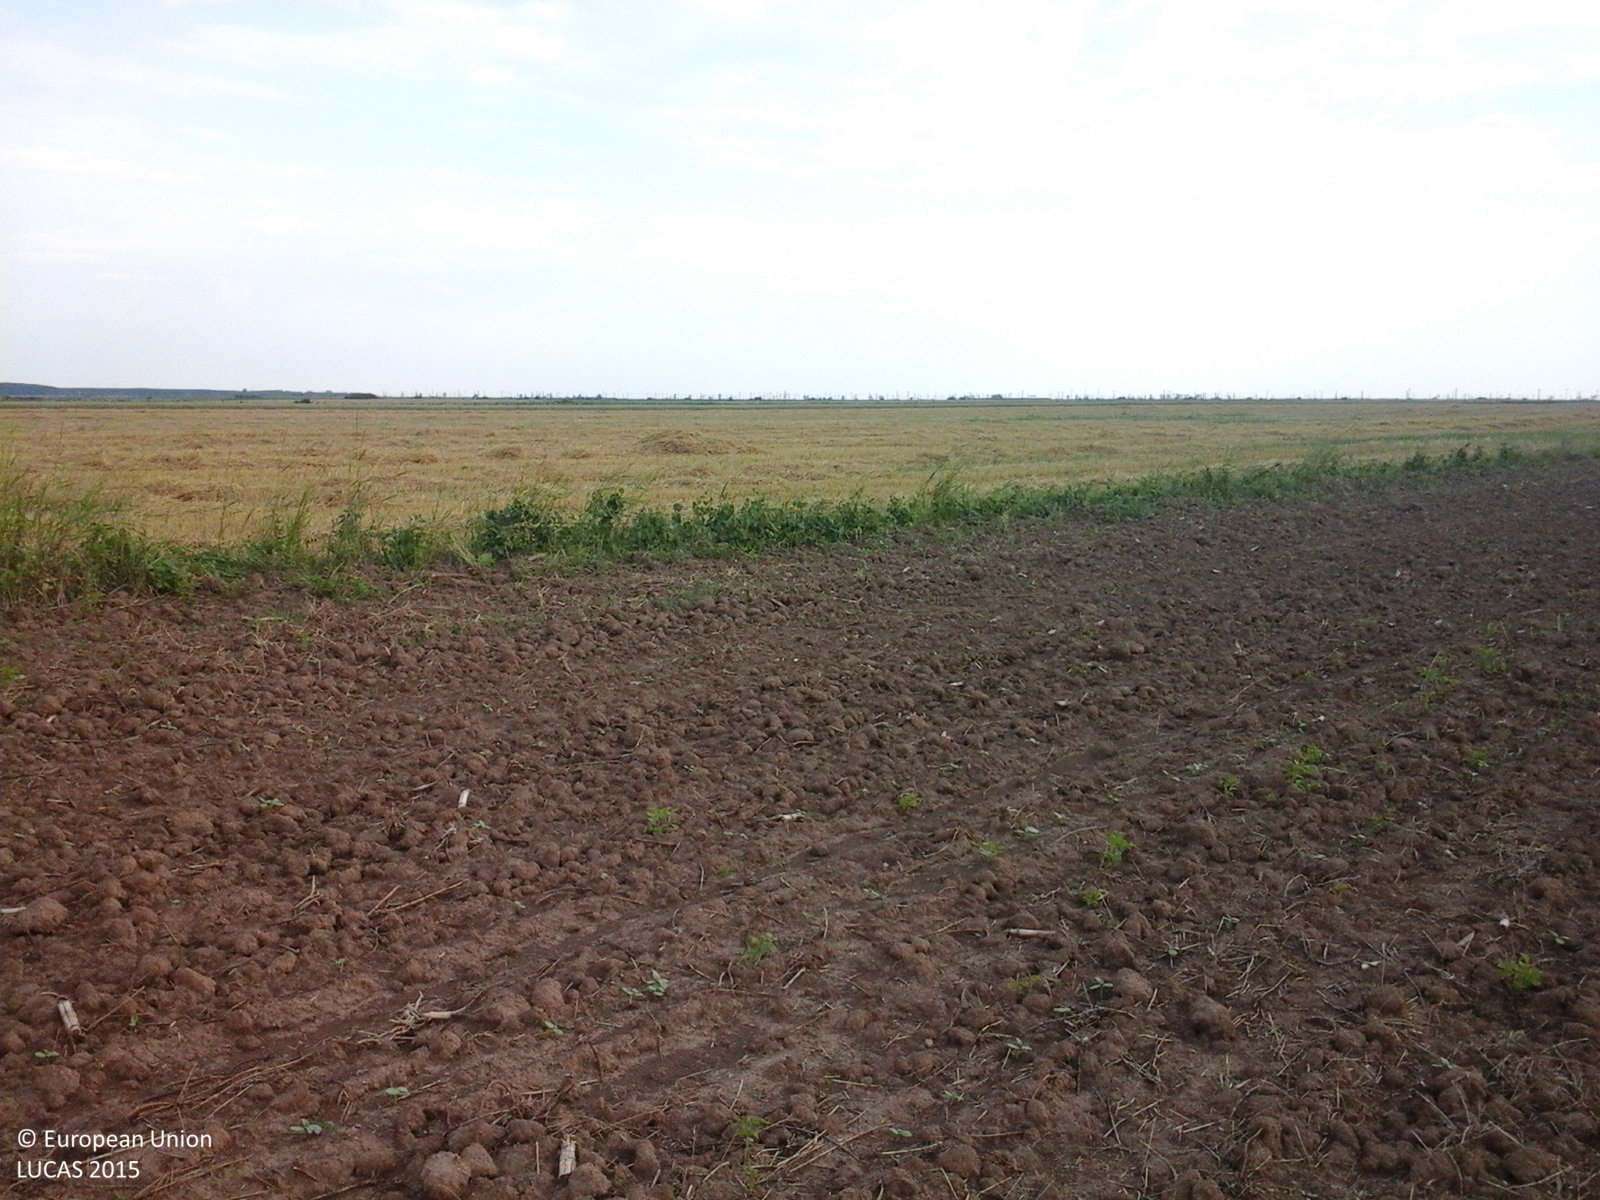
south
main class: Cropland
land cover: Sunflower
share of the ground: < 10 %
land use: Agriculture (excluding fallow land and kitchen gardens)
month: July
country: RO
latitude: 44.3387
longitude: 25.5819
